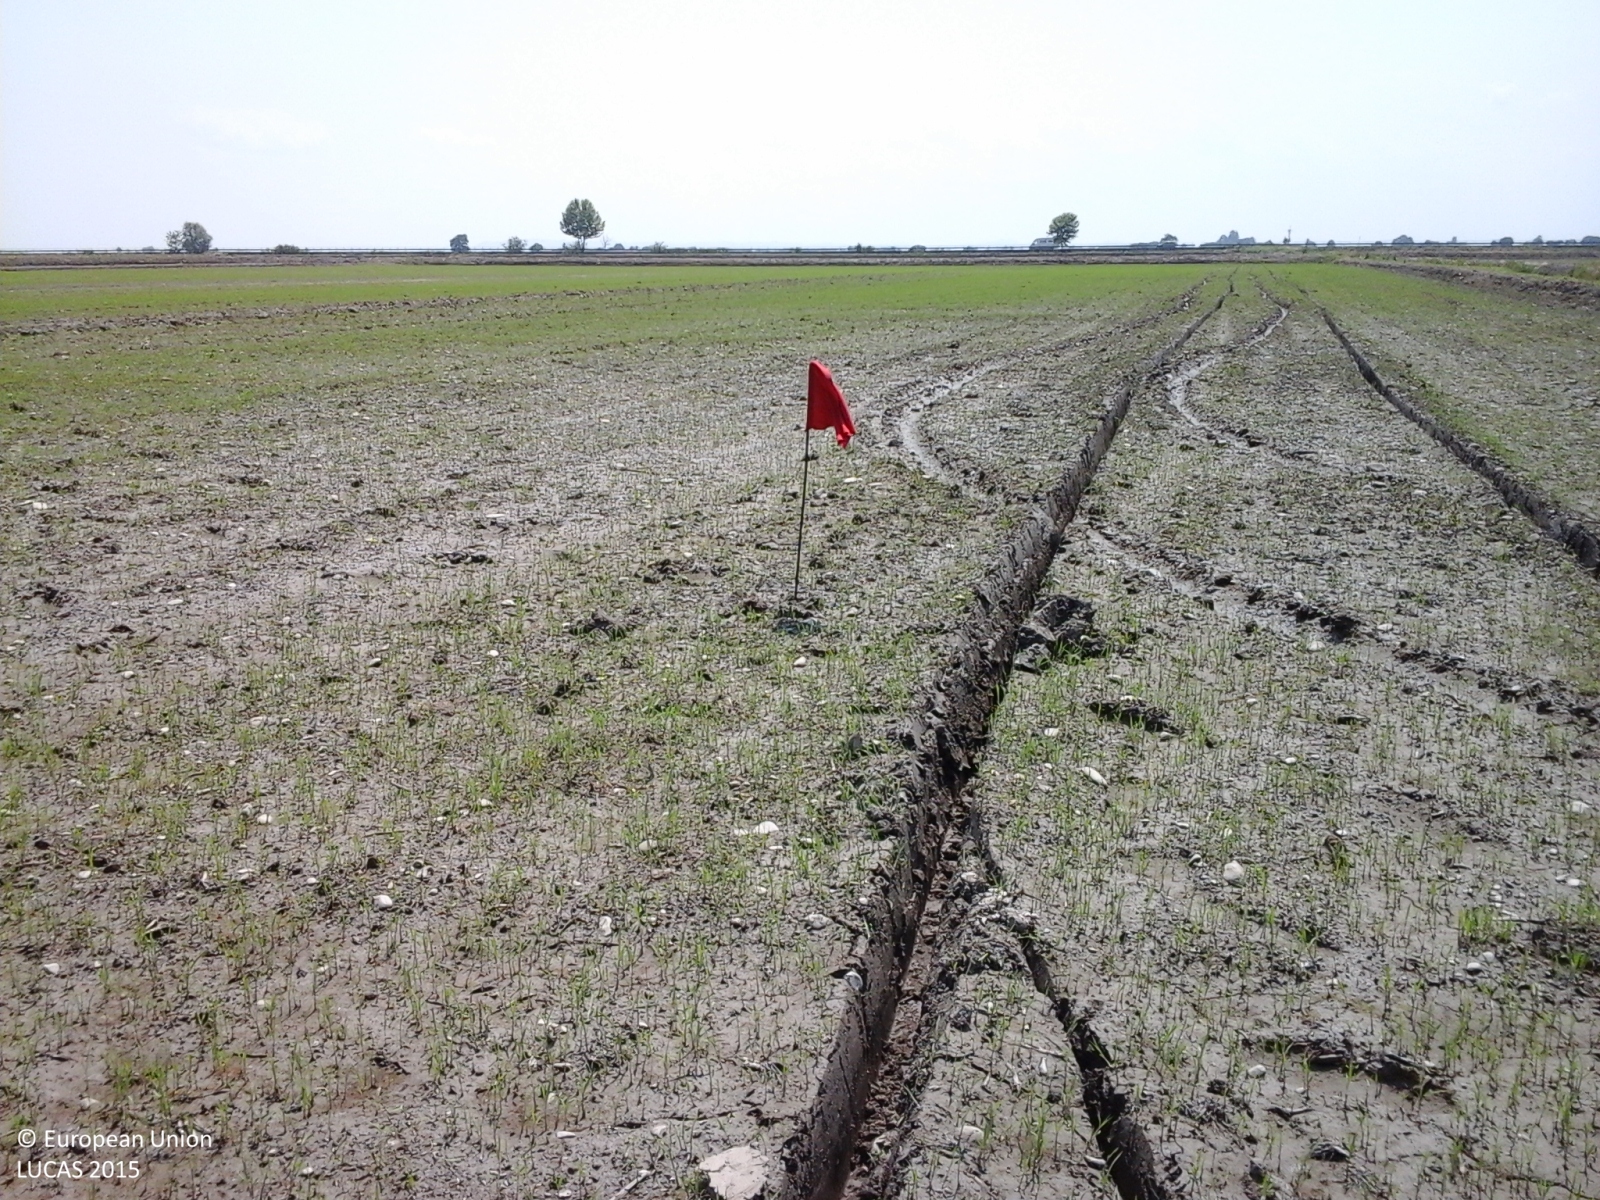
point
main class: Cropland
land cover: Rice
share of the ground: < 10 %
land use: Agriculture (excluding fallow land and kitchen gardens)
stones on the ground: < 10 %
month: May
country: IT
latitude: 45.3462
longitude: 8.2799
